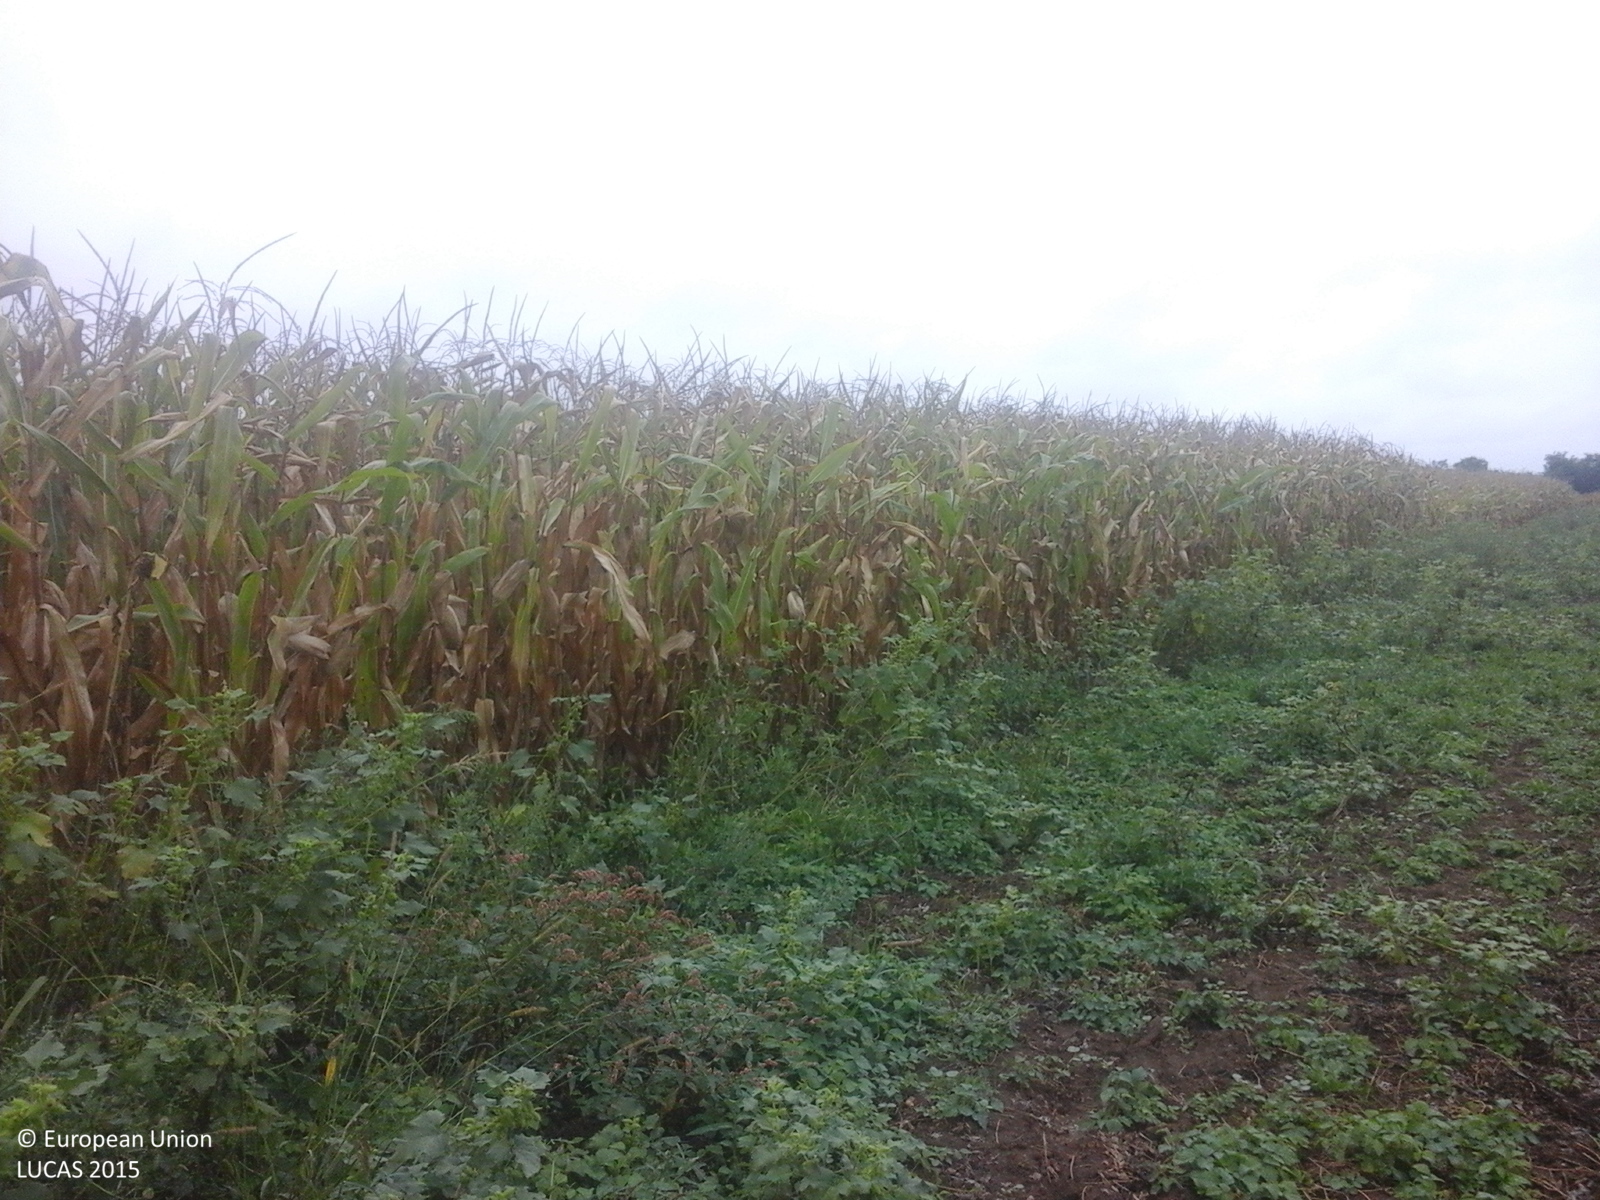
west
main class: Cropland
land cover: Maize
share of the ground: > 75 %
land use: Agriculture (excluding fallow land and kitchen gardens)
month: September
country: RO
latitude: 47.2198
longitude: 21.9989
